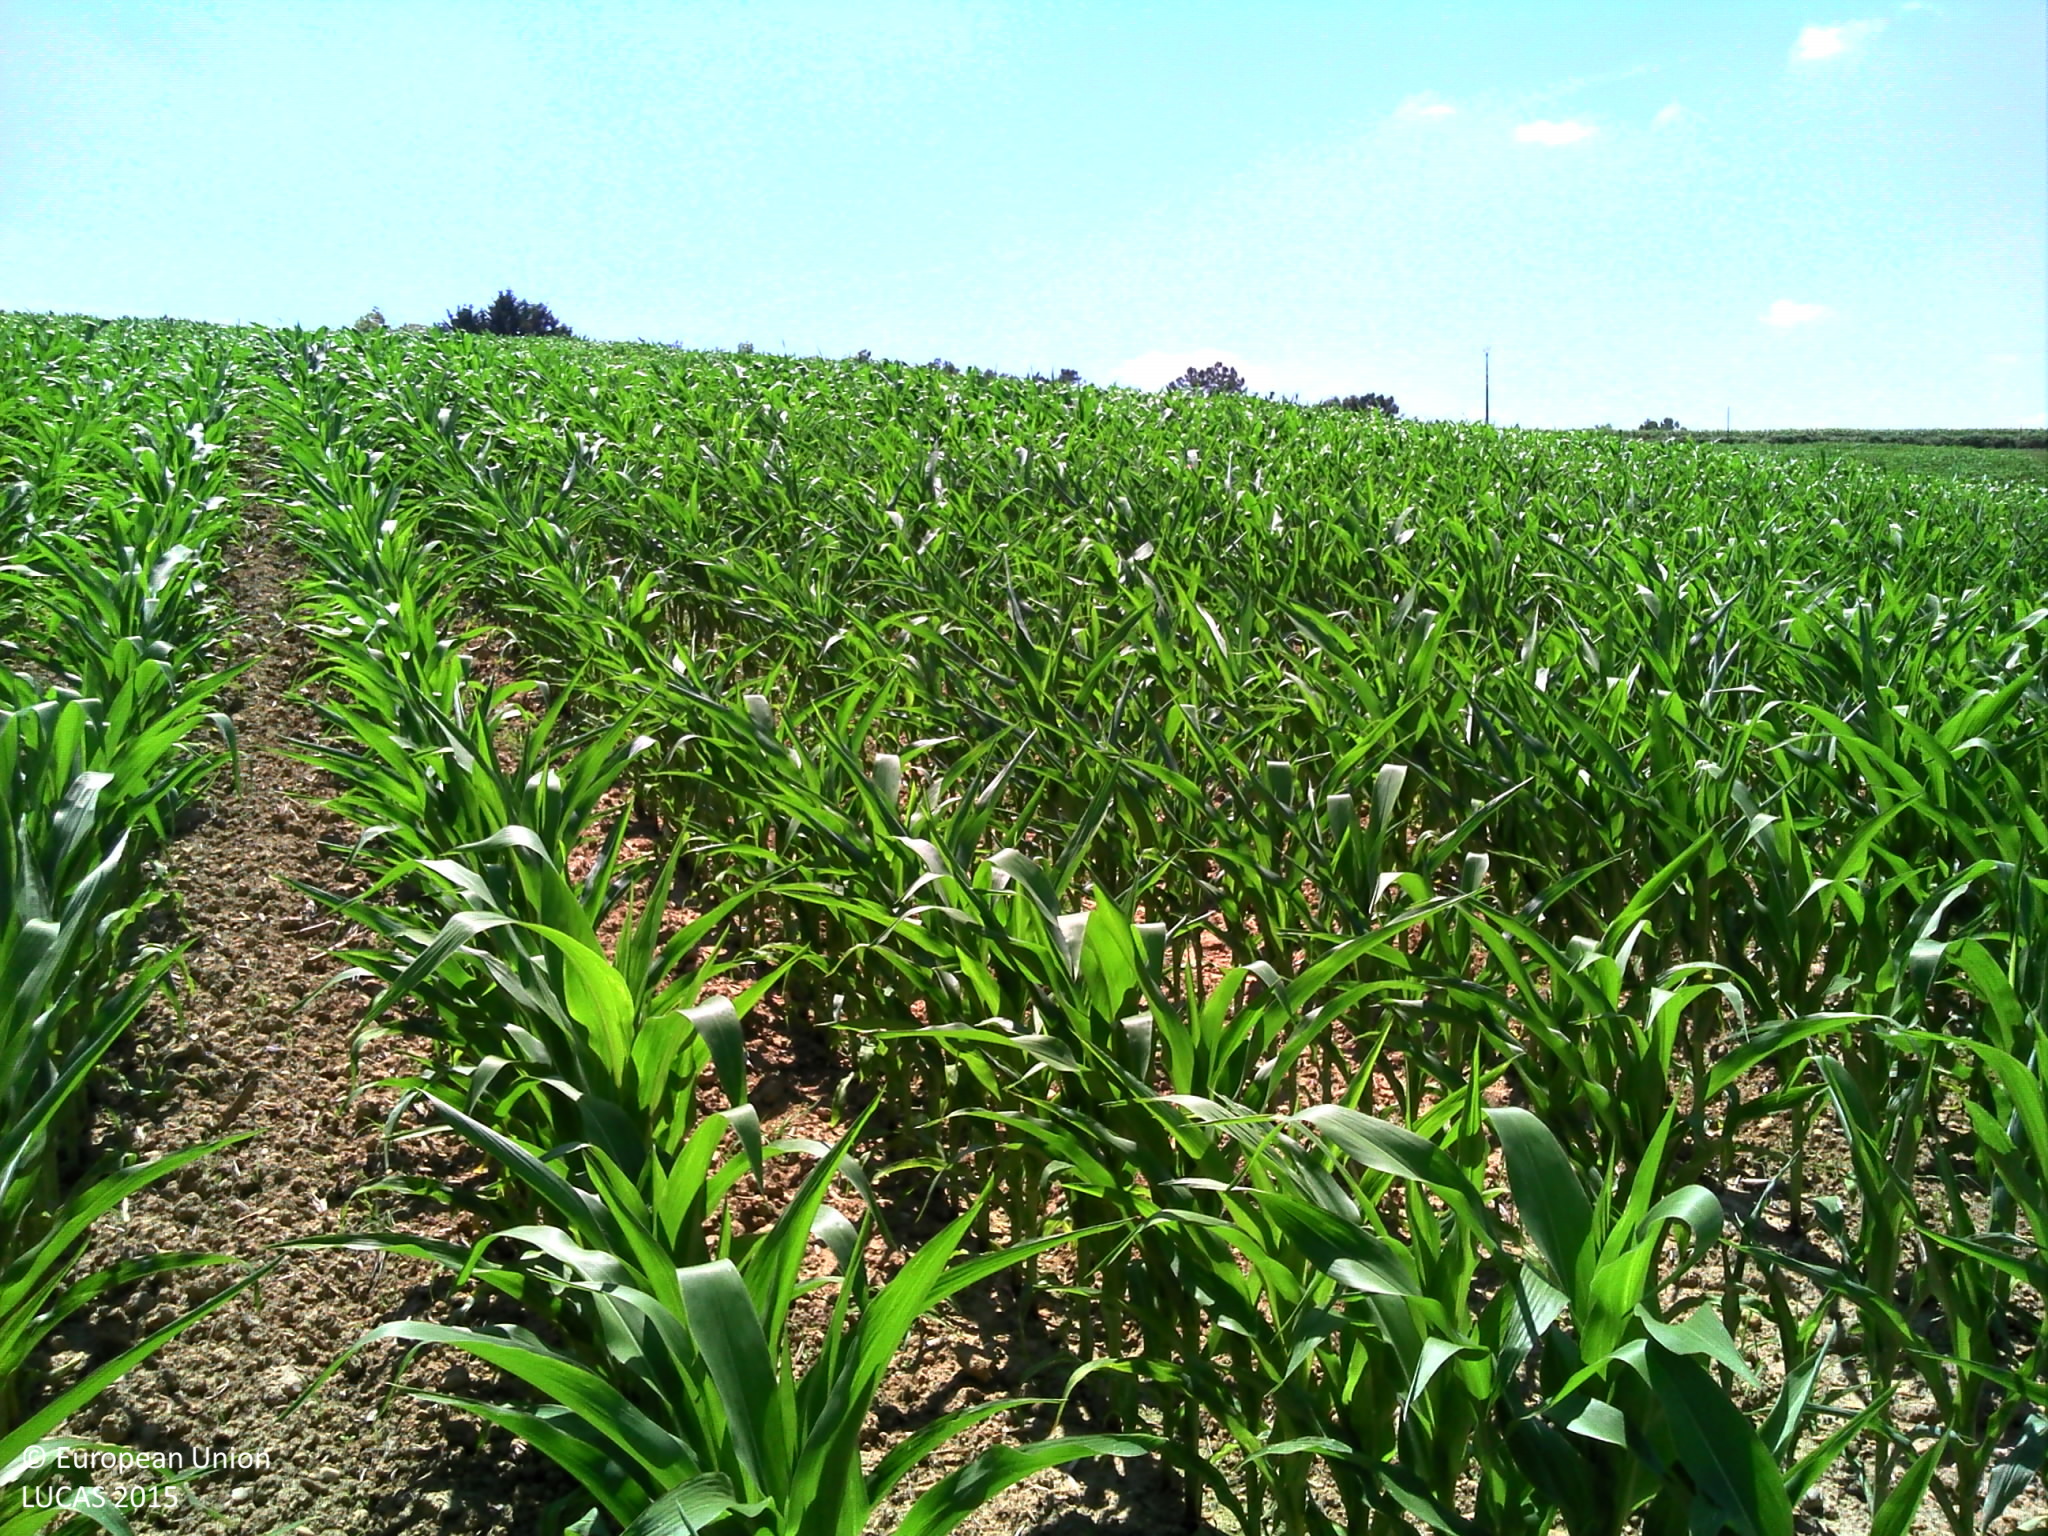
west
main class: Cropland
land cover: Maize
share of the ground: 50 - 75 %
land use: Agriculture (excluding fallow land and kitchen gardens)
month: June
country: FR
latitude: 43.6998
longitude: -0.3956
